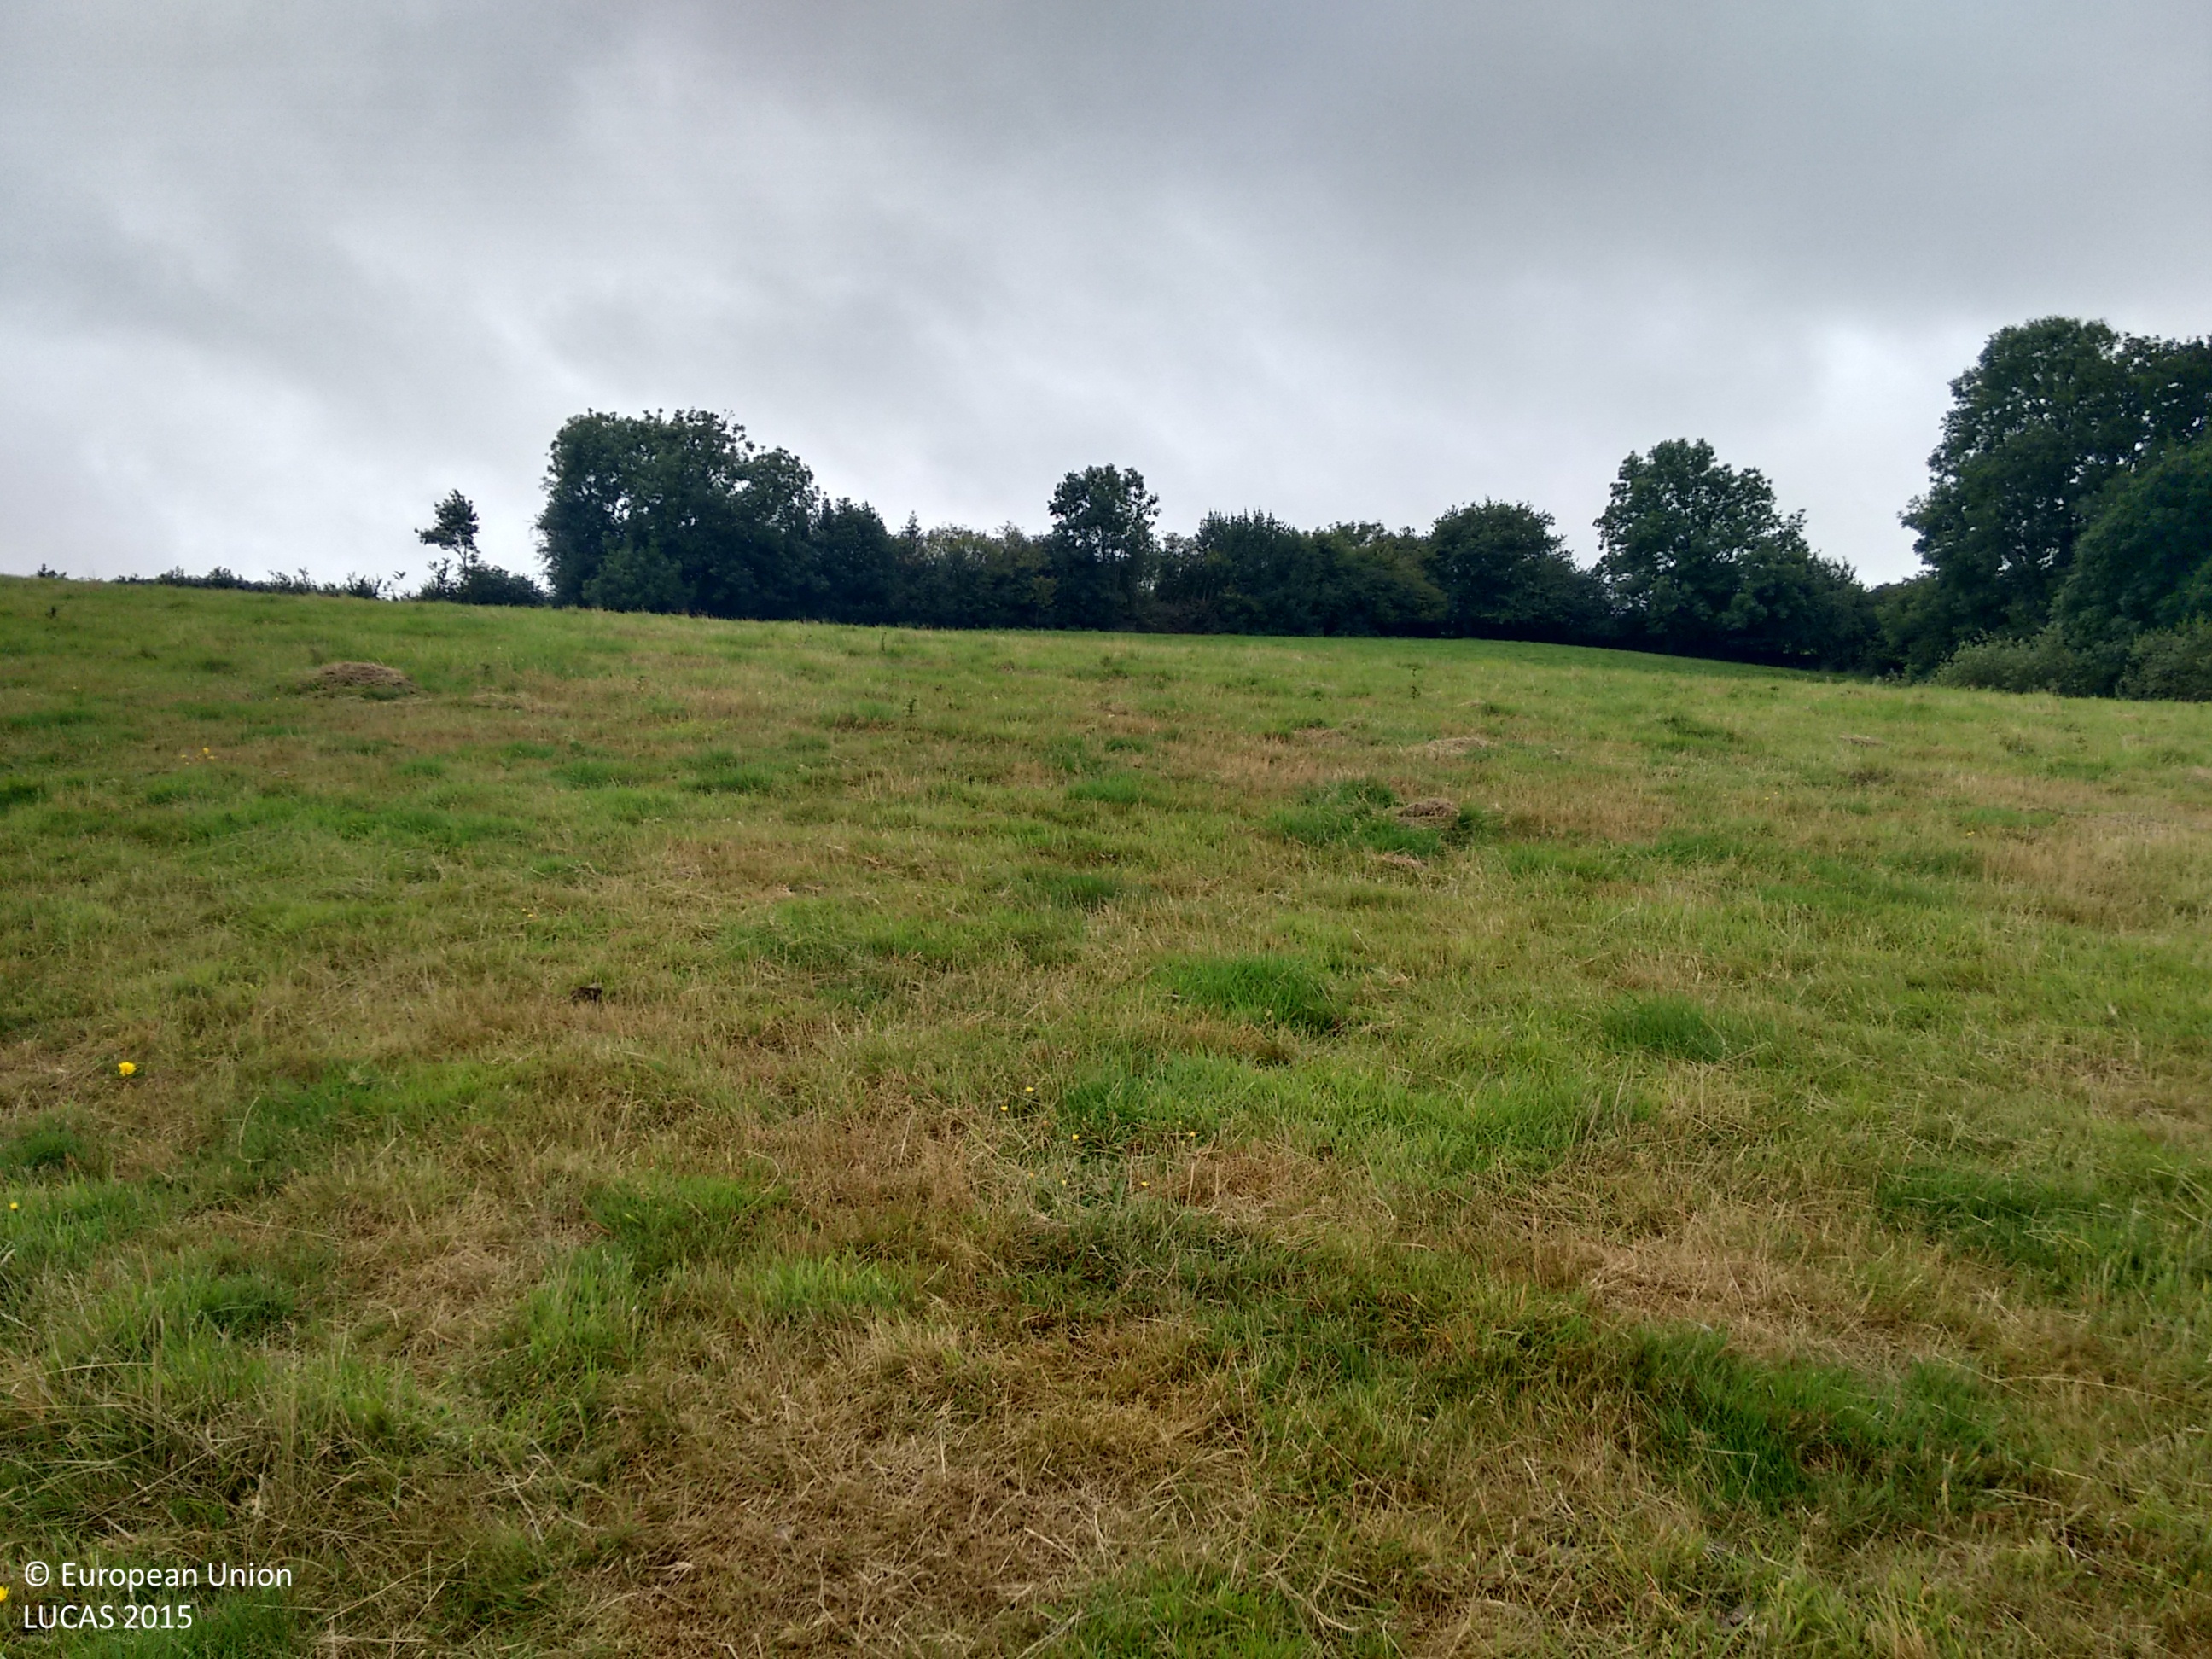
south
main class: Grassland
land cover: Grassland without tree/shrub cover
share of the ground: > 75 %
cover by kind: herbaceous plants 100 %
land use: Agriculture (excluding fallow land and kitchen gardens)
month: August
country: GB
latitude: 50.8539
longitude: -3.6529
